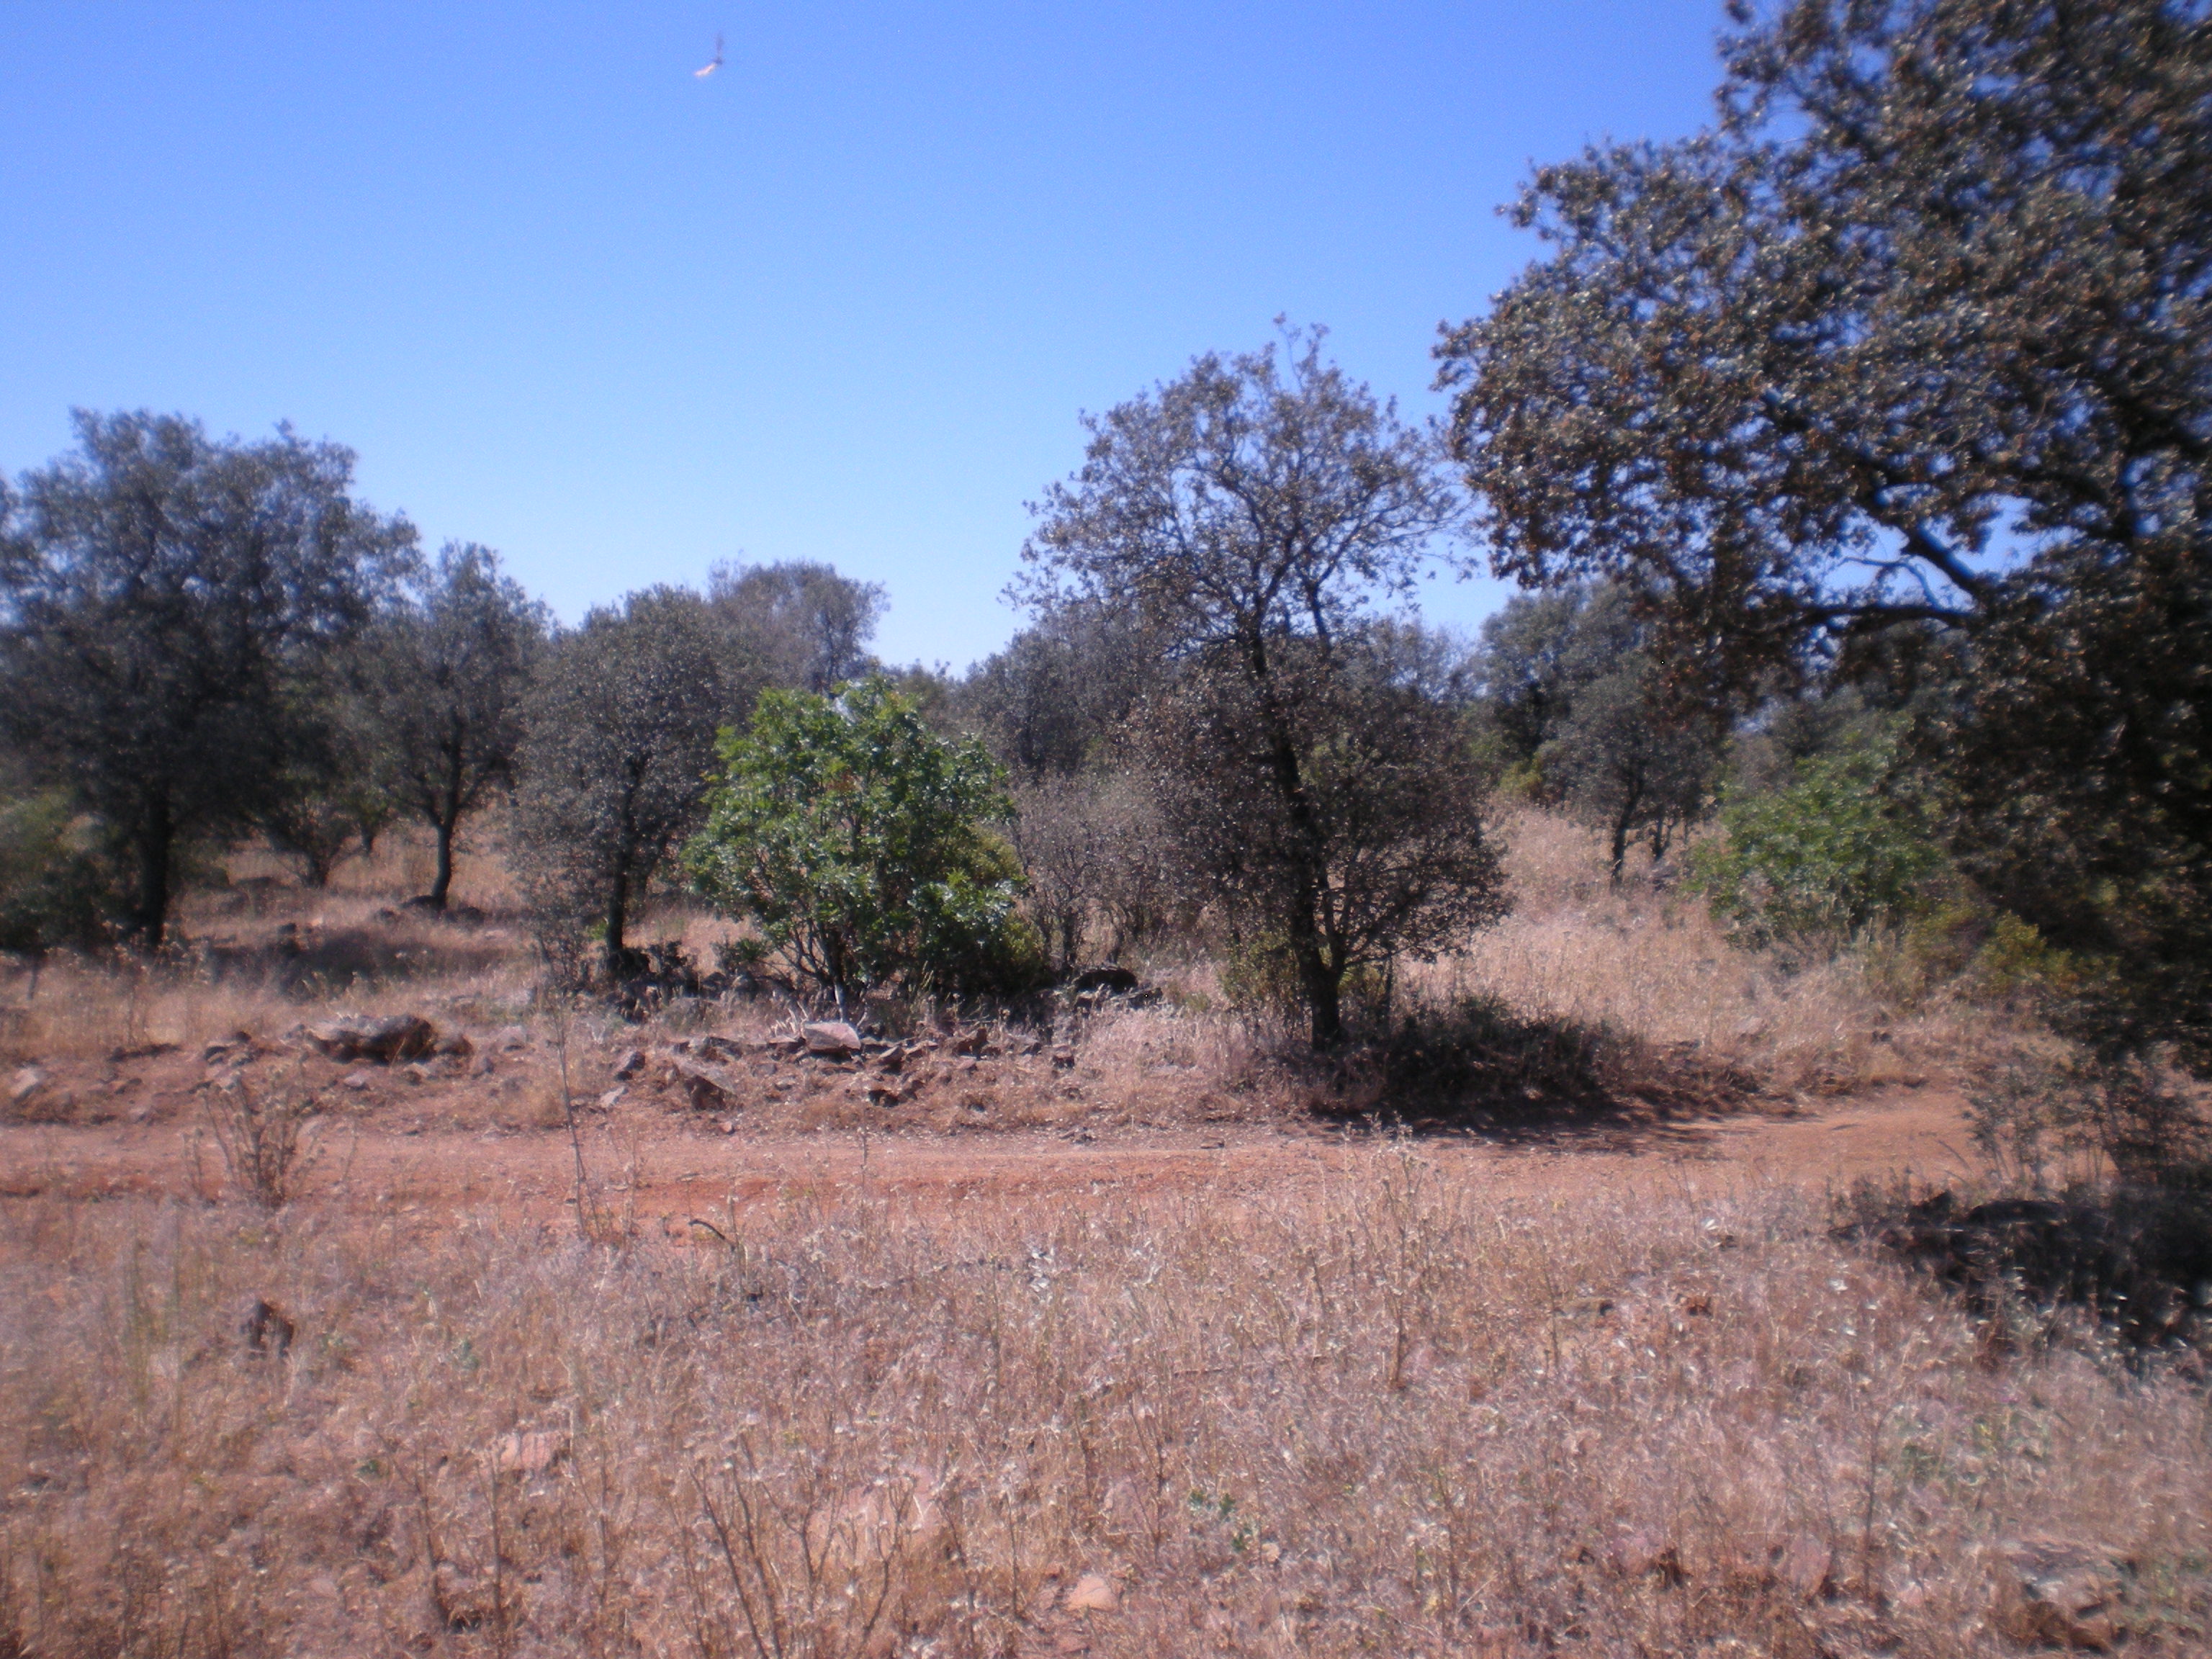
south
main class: Grassland
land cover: Grassland with sparse tree/shrub cover
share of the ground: > 75 %
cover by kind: unconsolidated bare surface 80 %, herbaceous plants 15 %, broadleaved forest trees 5 %
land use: Agriculture (excluding fallow land and kitchen gardens)
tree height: < 5 m
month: May
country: ES
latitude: 38.5136
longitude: -3.4377
